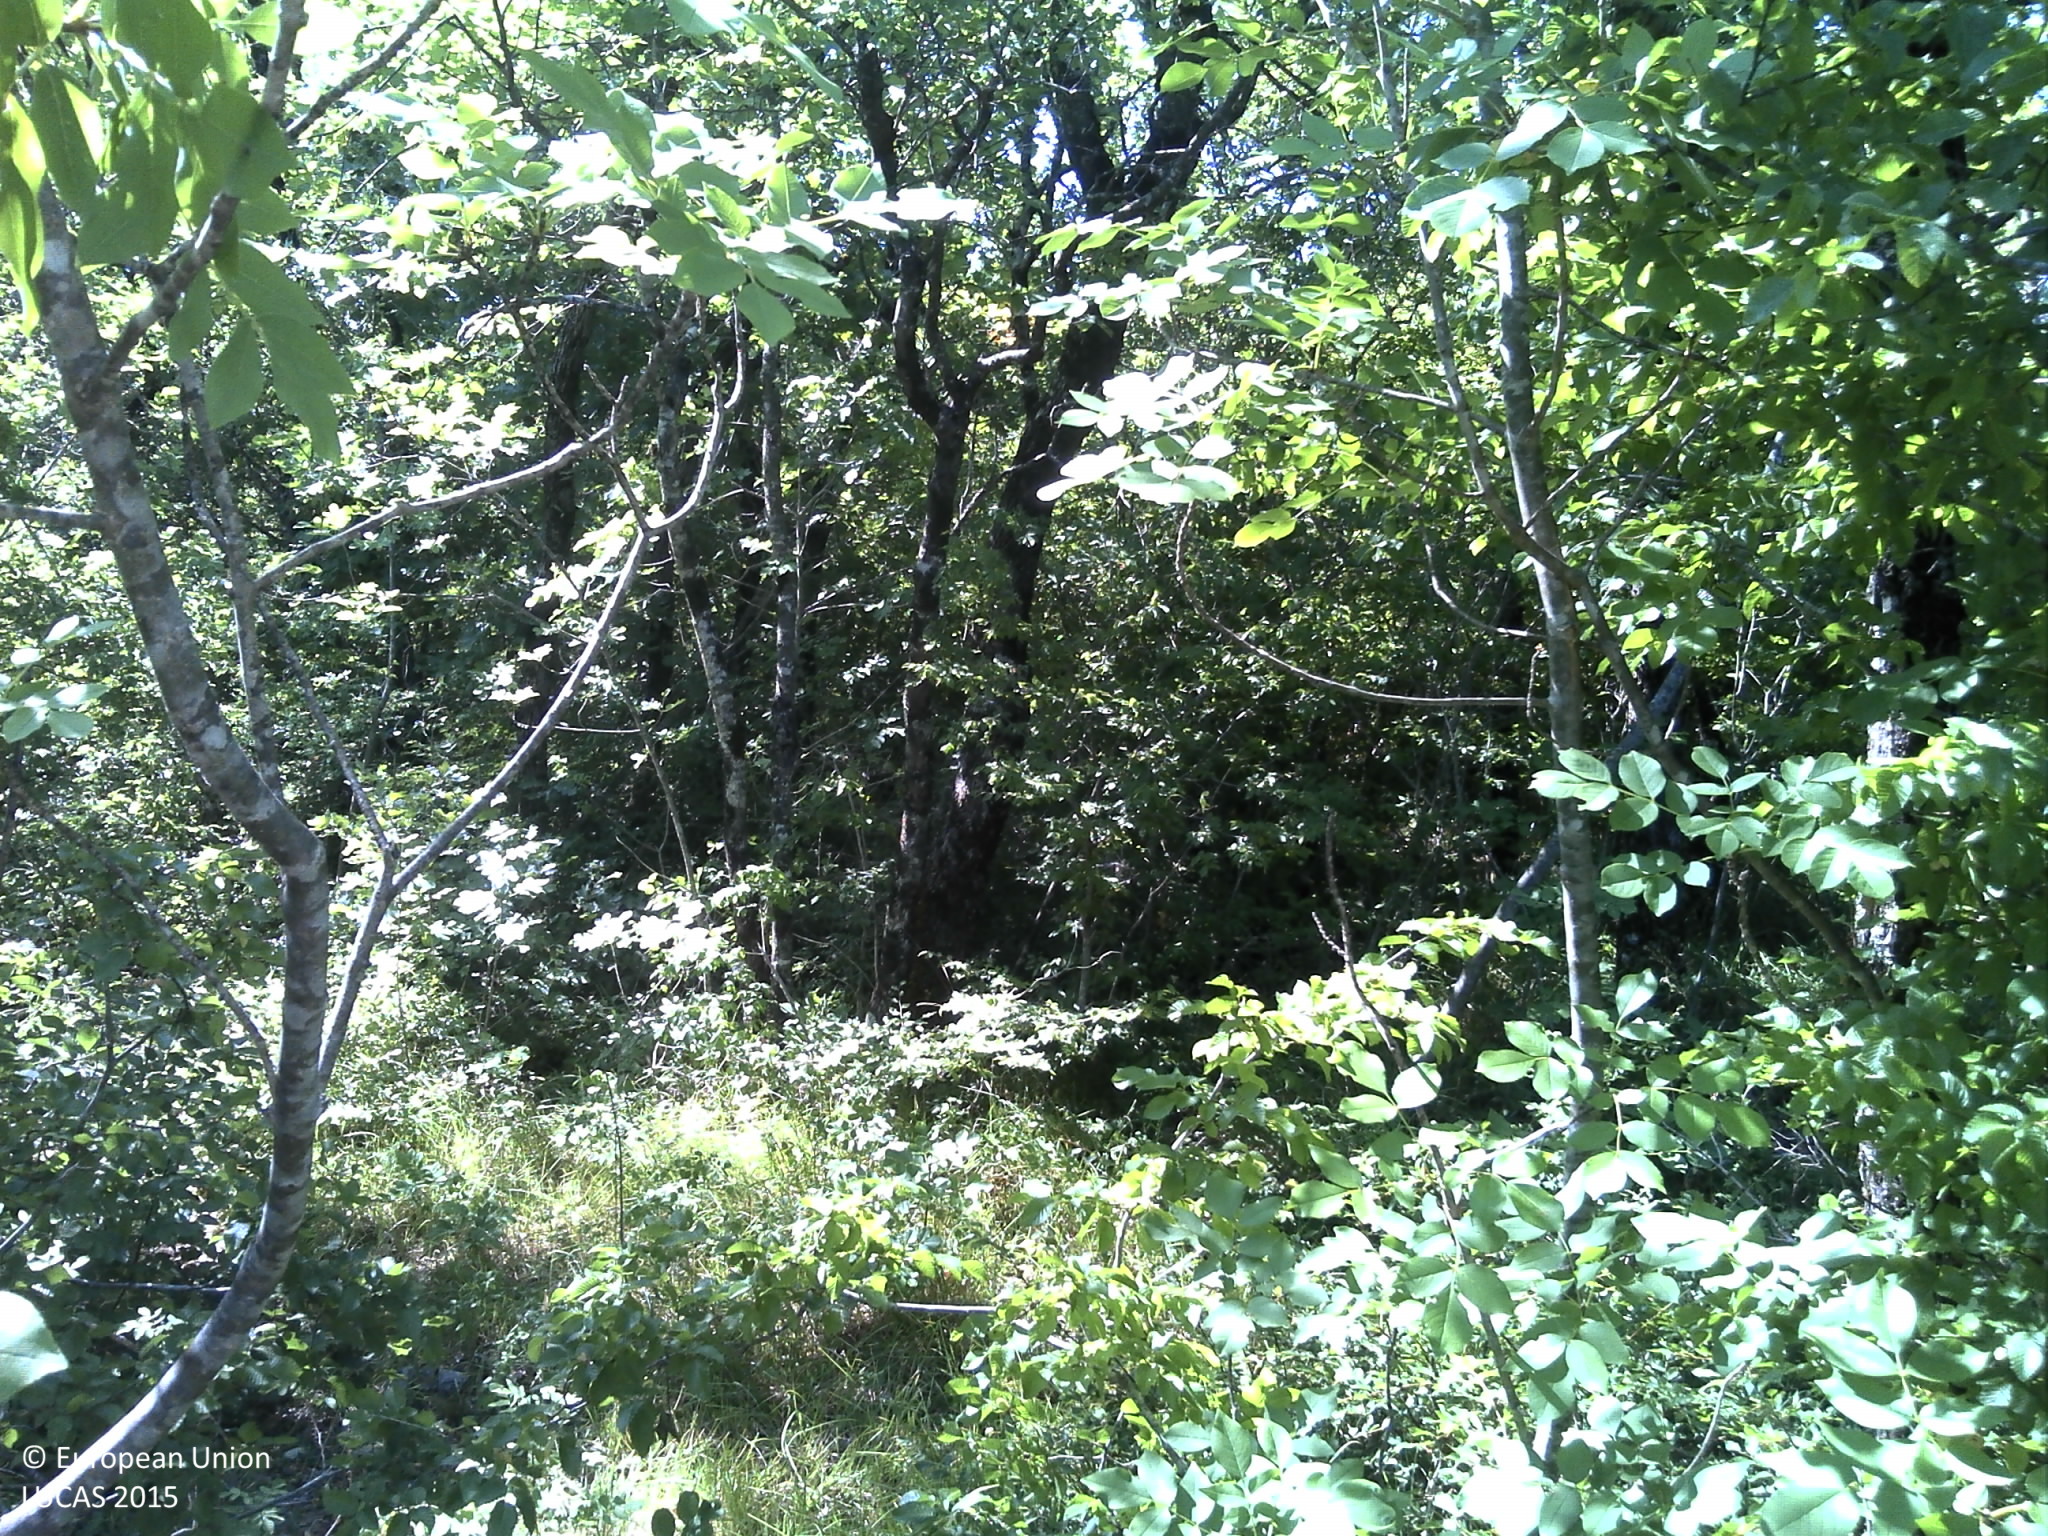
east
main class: Shrubland
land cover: Shrubland with sparse tree cover
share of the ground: > 75 %
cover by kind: shrubs 75 %, herbaceous plants 10 %, broadleaved forest trees 5 %, lichens and mosses 5 %, consolidated bare surface 5 %
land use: Semi-natural and natural areas not in use
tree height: > 5 m
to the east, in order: Shrubland with sparse tree cover; Dry stone walls; Broadleaved woodland; Dry stone walls; Broadleaved woodland; Grassland with sparse tree/shrub cover; Broadleaved woodland; Dry stone walls; Shrubland with sparse tree cover; Dry stone walls; Grassland without tree/shrub cover
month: July
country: HR
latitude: 43.5521
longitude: 17.0104
